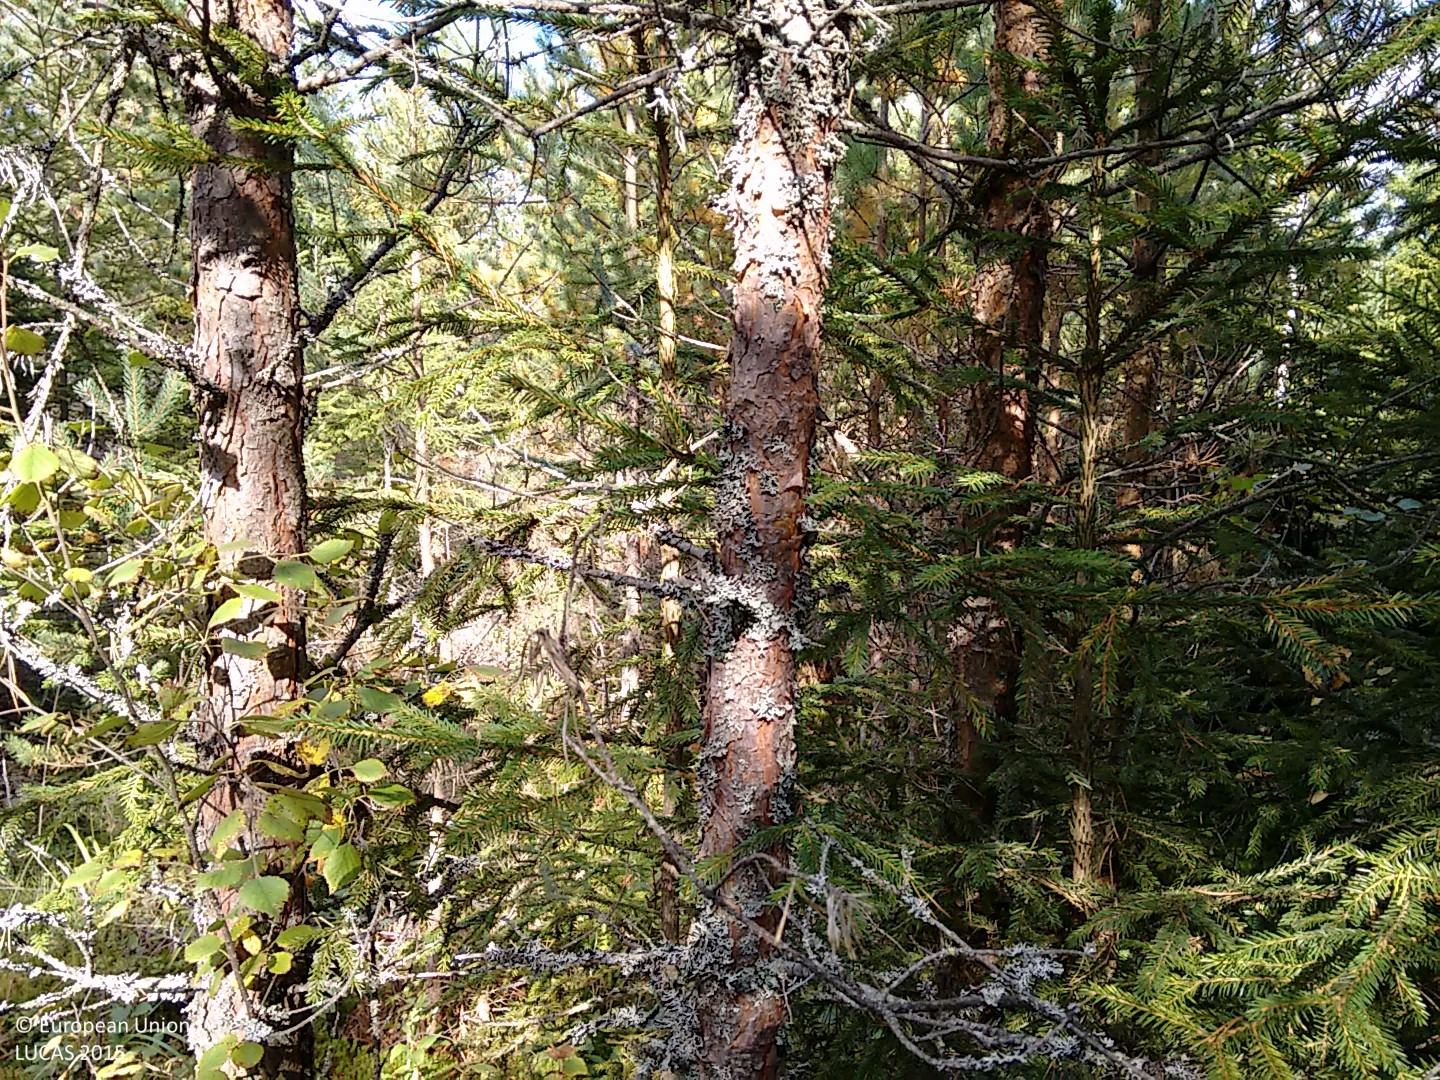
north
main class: Woodland
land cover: Spruce dominated coniferous woodland
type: hemiboreal forest and nemoral coniferous forest and mixed broadleaved-coniferous forest
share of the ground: > 75 %
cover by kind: coniferous forest trees 90 %, shrubs 5 %, lichens and mosses 5 %
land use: Forestry
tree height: > 5 m
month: September
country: FI
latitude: 60.9997
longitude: 21.7615
